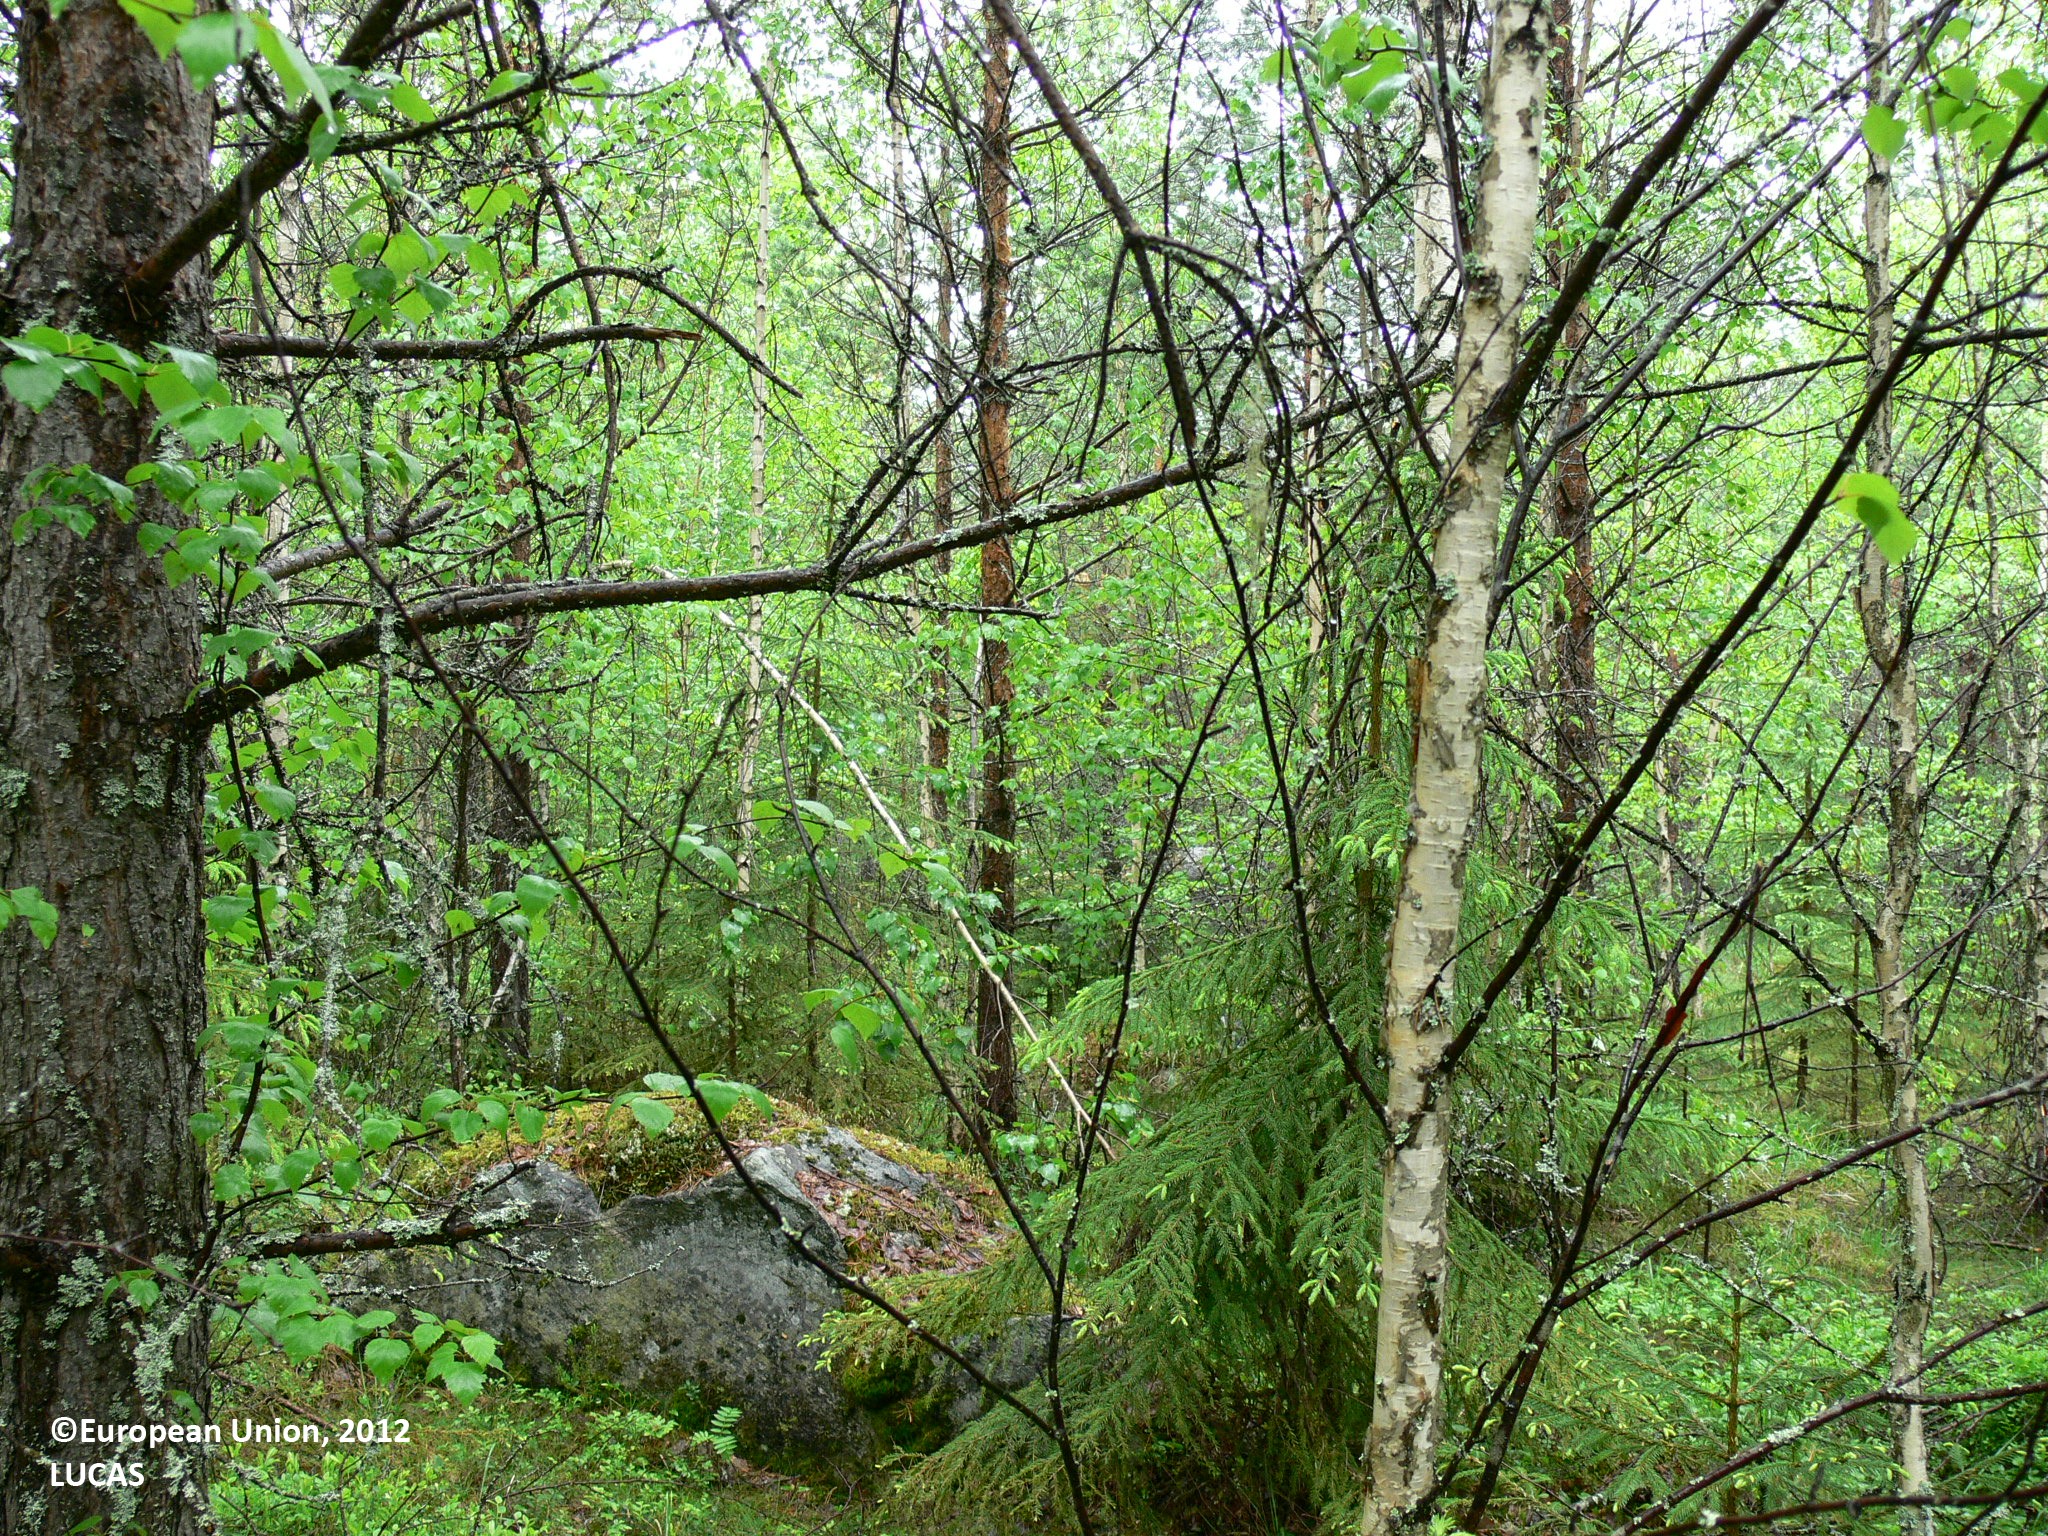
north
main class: Woodland
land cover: Other mixed woodland
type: boreal forest
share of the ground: > 75 %
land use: Forestry
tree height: > 5 m
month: June
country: FI
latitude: 62.5284
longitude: 30.3476
